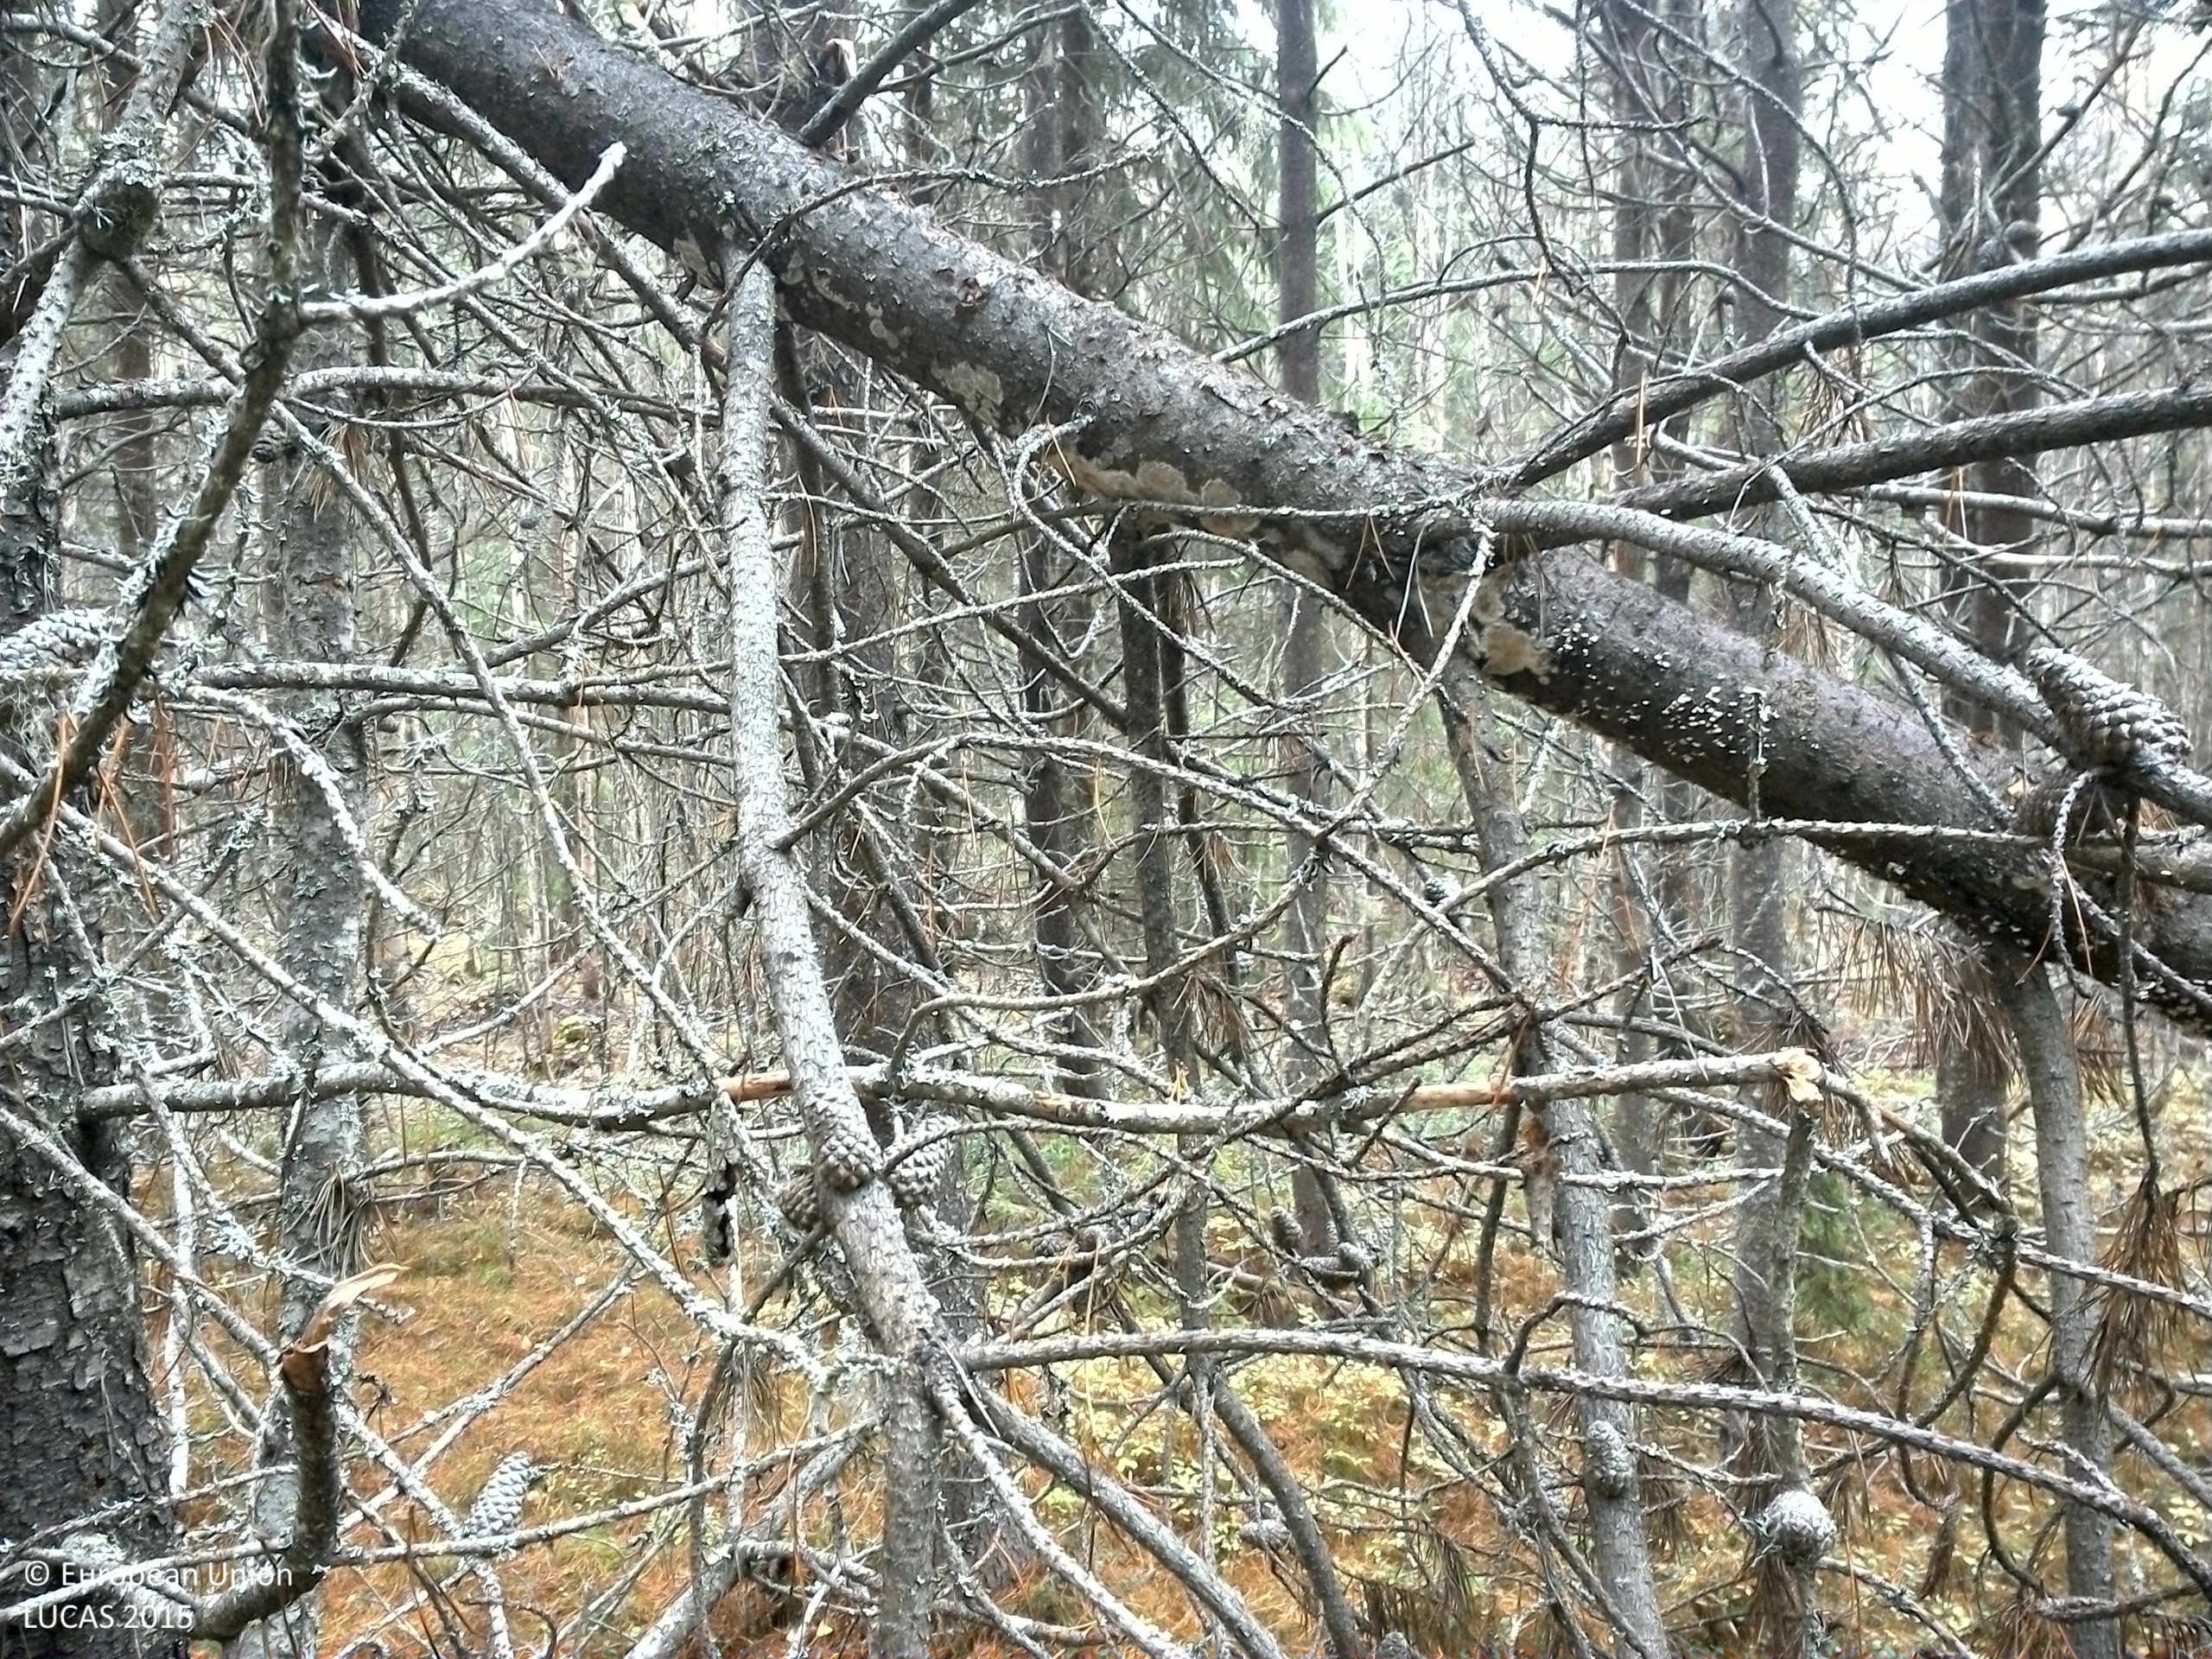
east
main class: Woodland
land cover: Pine dominated coniferous woodland
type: exotic forest
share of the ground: 50 - 75 %
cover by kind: coniferous forest trees 60 %, lichens and mosses 20 %, shrubs 10 %, herbaceous plants 10 %
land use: Forestry
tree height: > 5 m
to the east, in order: Pine dominated coniferous woodland; Spruce dominated mixed woodland; Pine dominated coniferous woodland; Spruce dominated mixed woodland
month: October
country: SE
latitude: 64.1057
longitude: 15.9434
